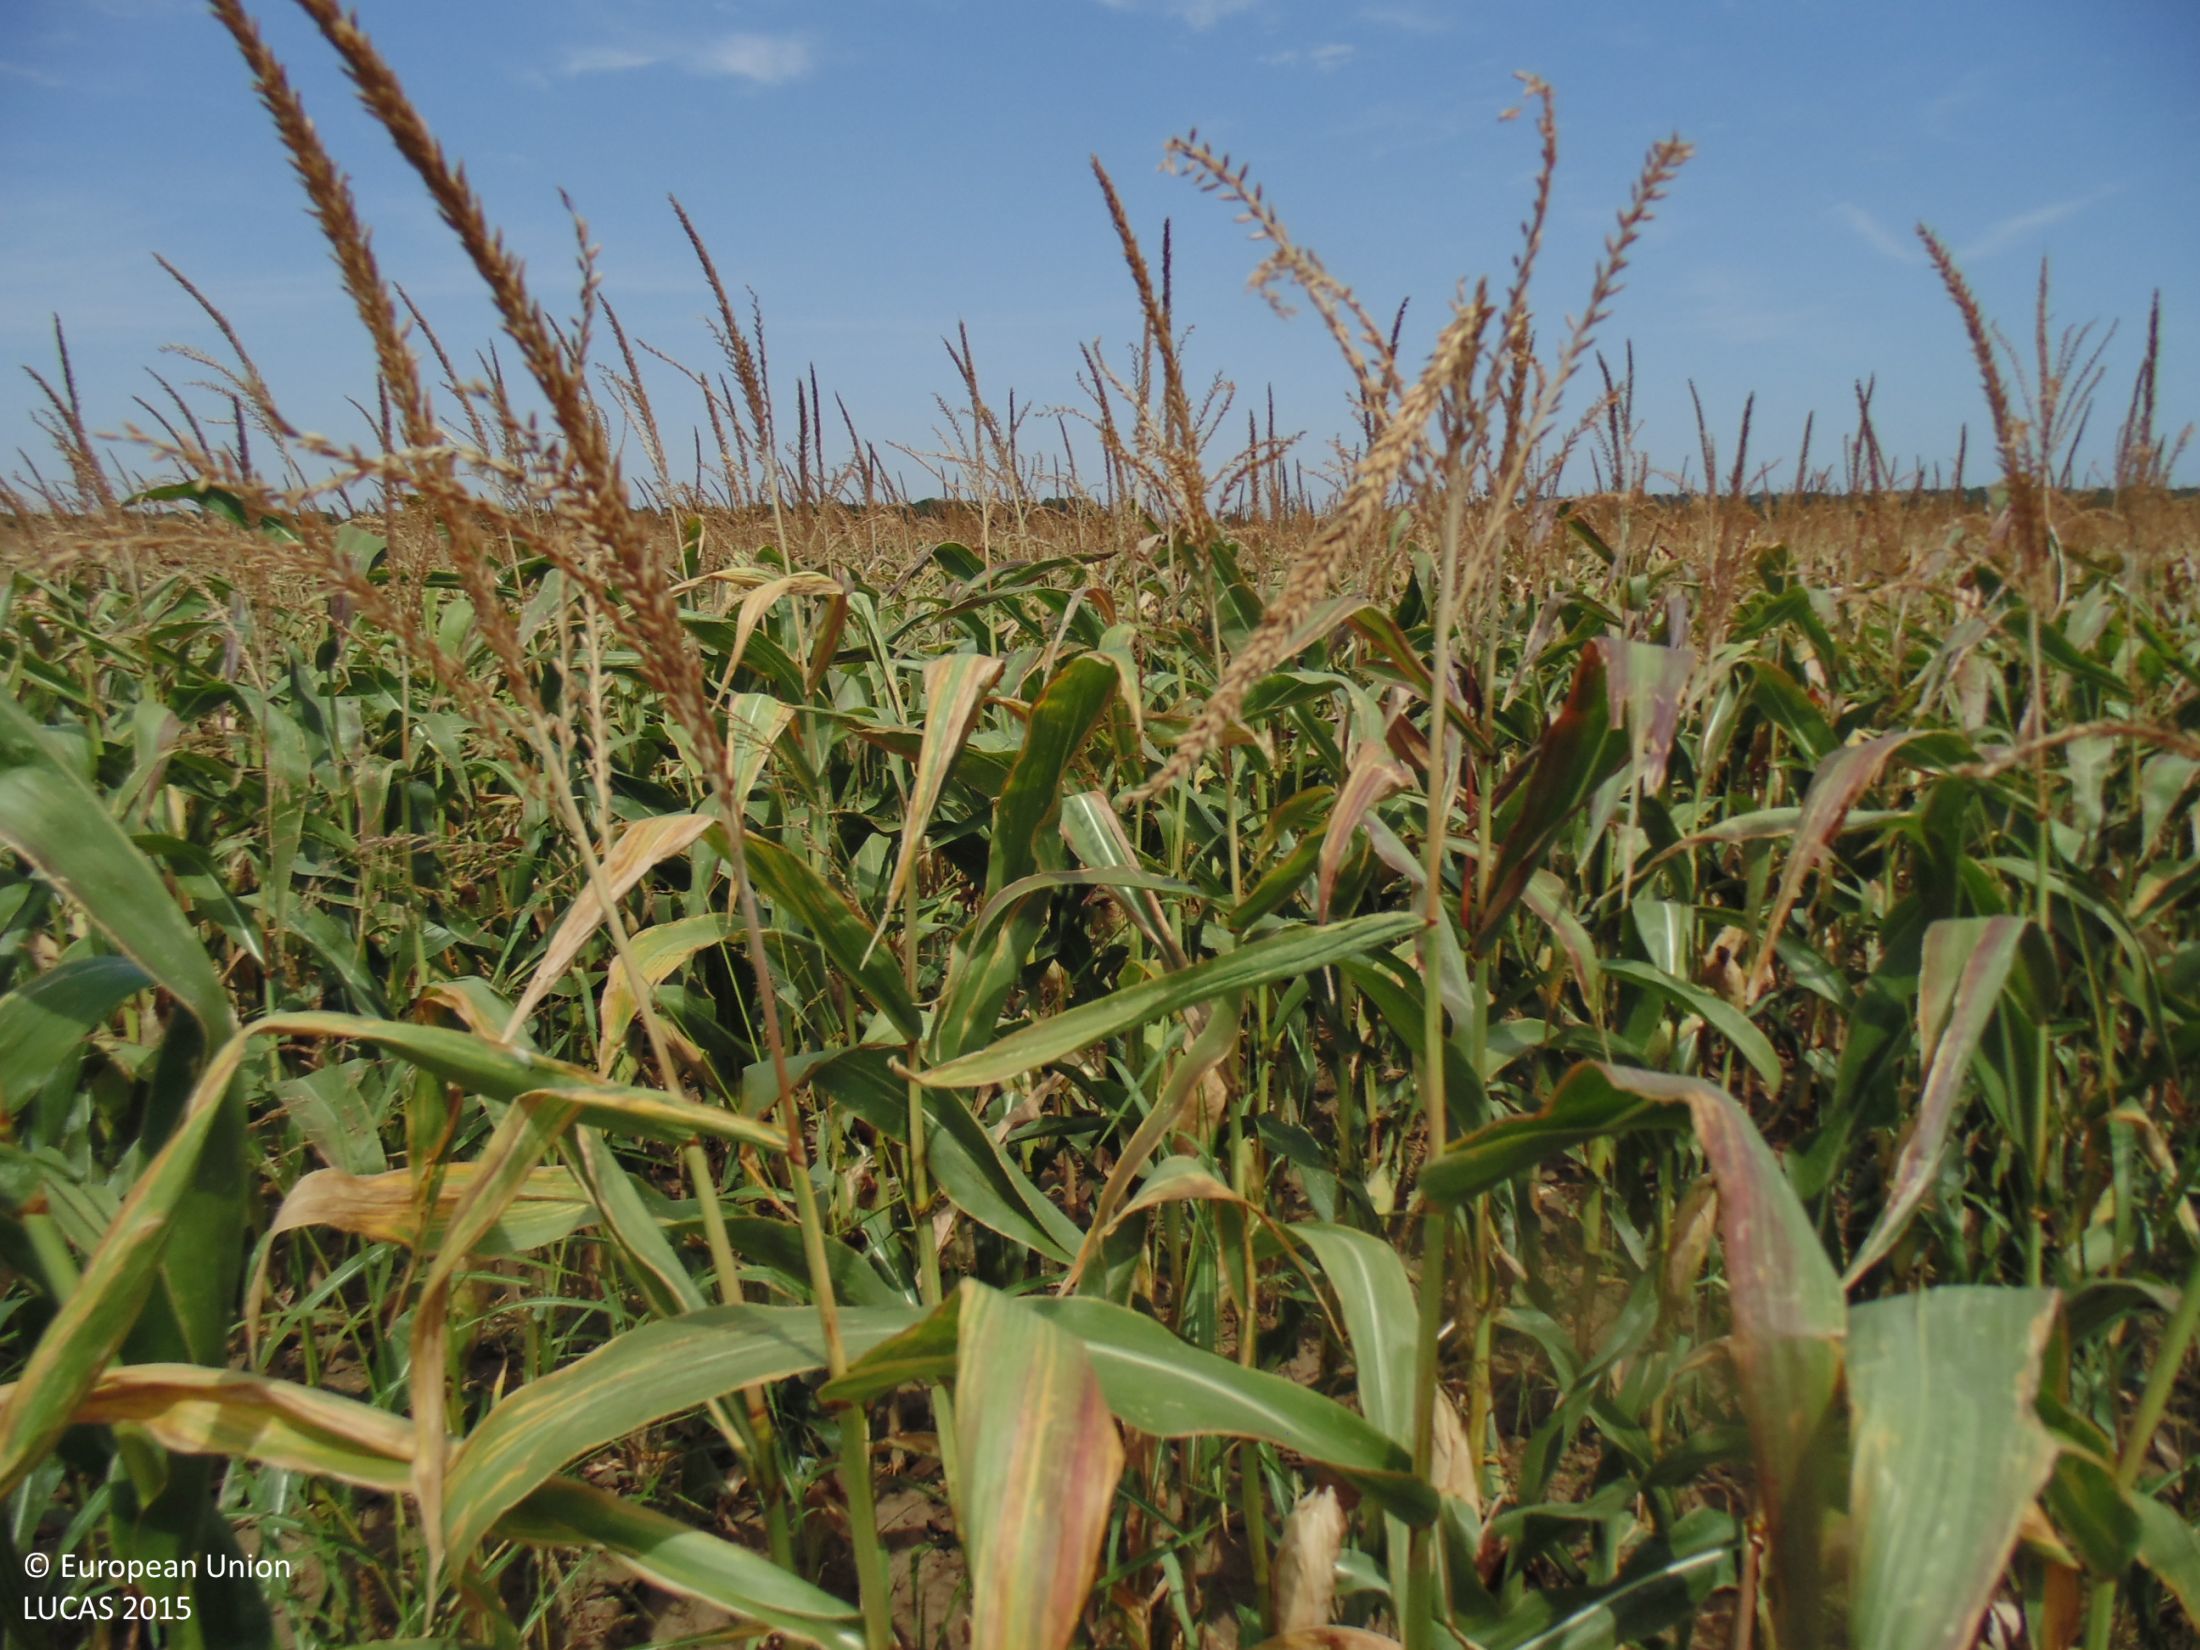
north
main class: Cropland
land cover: Maize
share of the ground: > 75 %
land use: Agriculture (excluding fallow land and kitchen gardens)
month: August
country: BG
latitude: 43.7133
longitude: 28.5464
